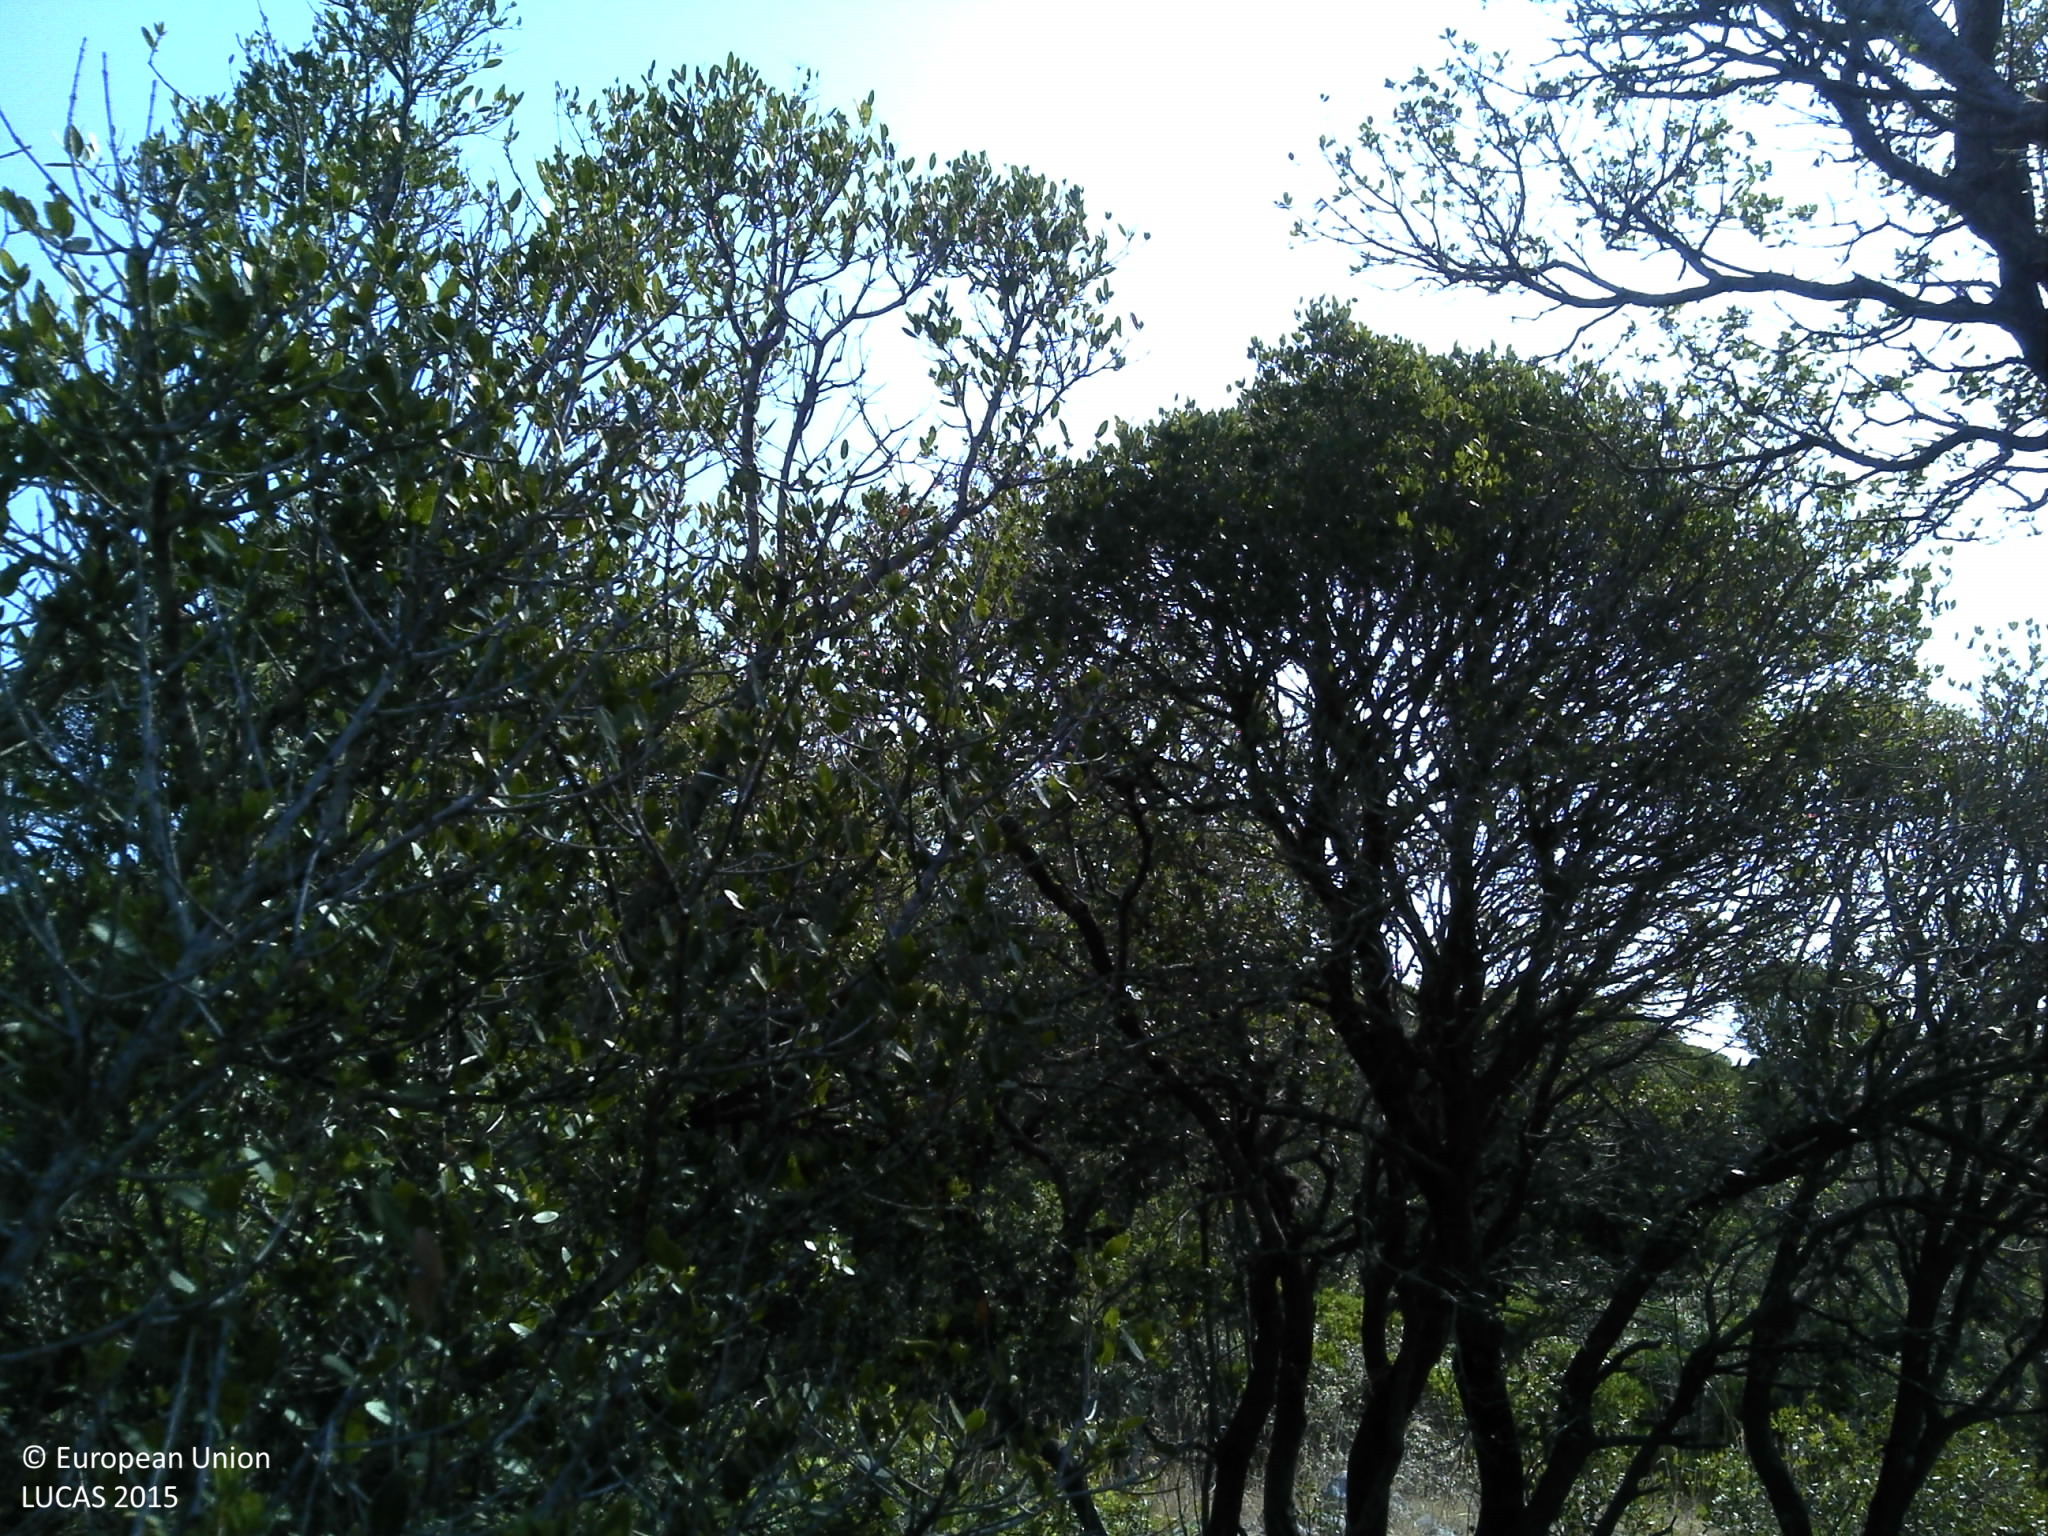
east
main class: Woodland
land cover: Broadleaved woodland
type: thermophilous deciduous forest
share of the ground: 50 - 75 %
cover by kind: broadleaved forest trees 50 %, shrubs 30 %, unconsolidated bare surface 20 %
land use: Semi-natural and natural areas not in use
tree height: > 5 m
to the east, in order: Broadleaved woodland; Grassland with sparse tree/shrub cover; Broadleaved woodland; Shrubland with sparse tree cover
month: July
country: HR
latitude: 44.6562
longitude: 14.7729
